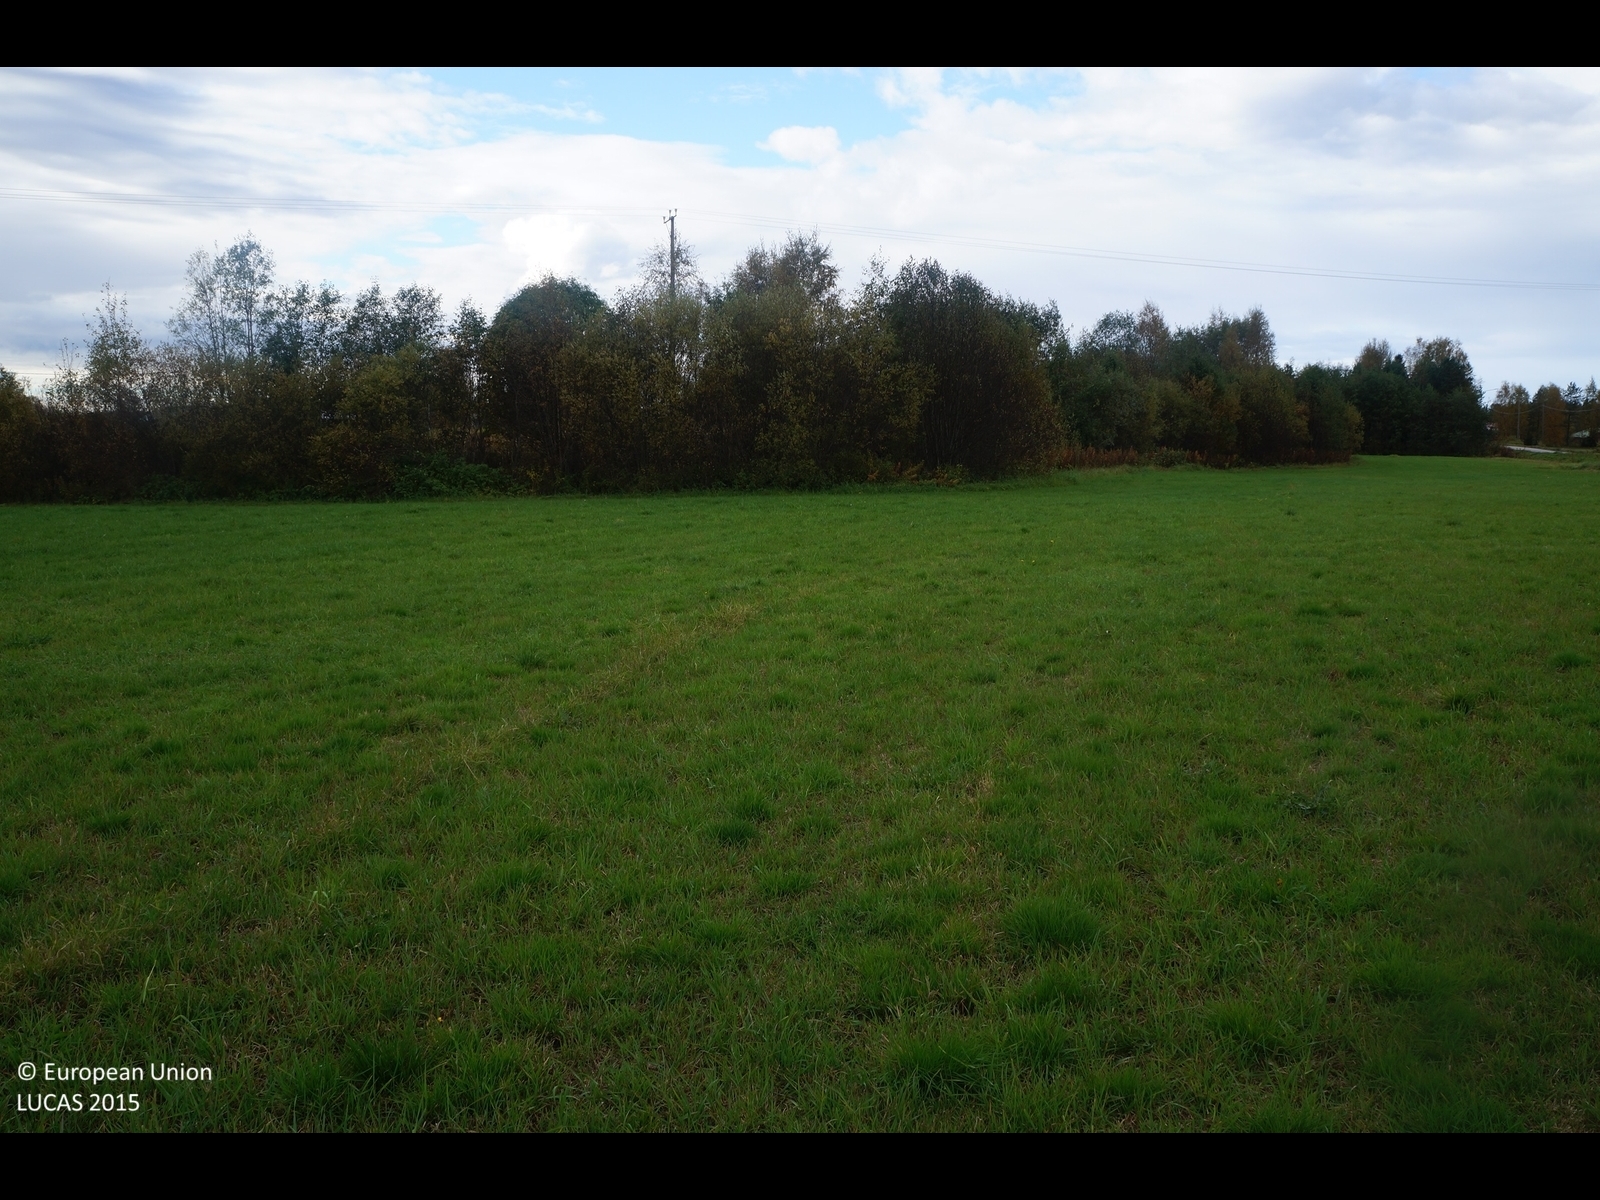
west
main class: Cropland
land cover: Temporary grasslands
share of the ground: > 75 %
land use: Agriculture (excluding fallow land and kitchen gardens)
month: September
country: FI
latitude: 64.4073
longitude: 24.3209
